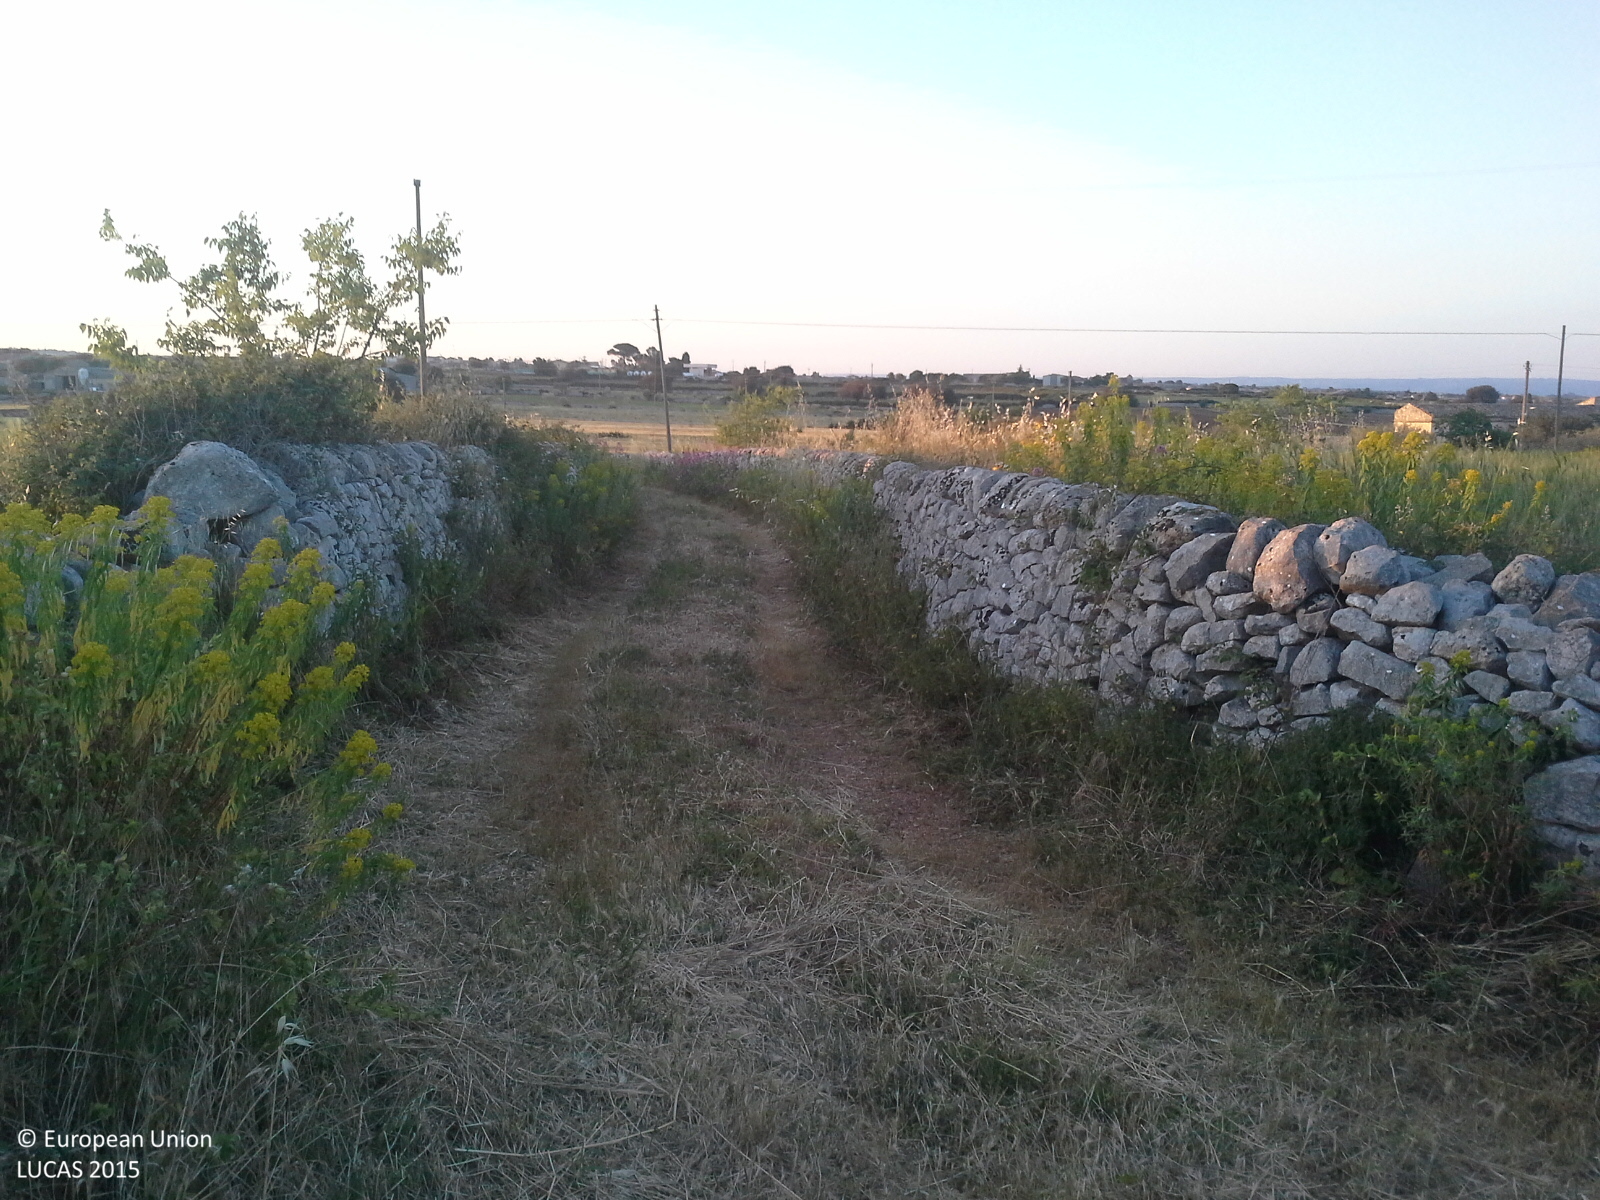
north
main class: Cropland
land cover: Durum wheat
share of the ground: > 75 %
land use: Agriculture (excluding fallow land and kitchen gardens)
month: May
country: IT
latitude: 36.8251
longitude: 14.8159
